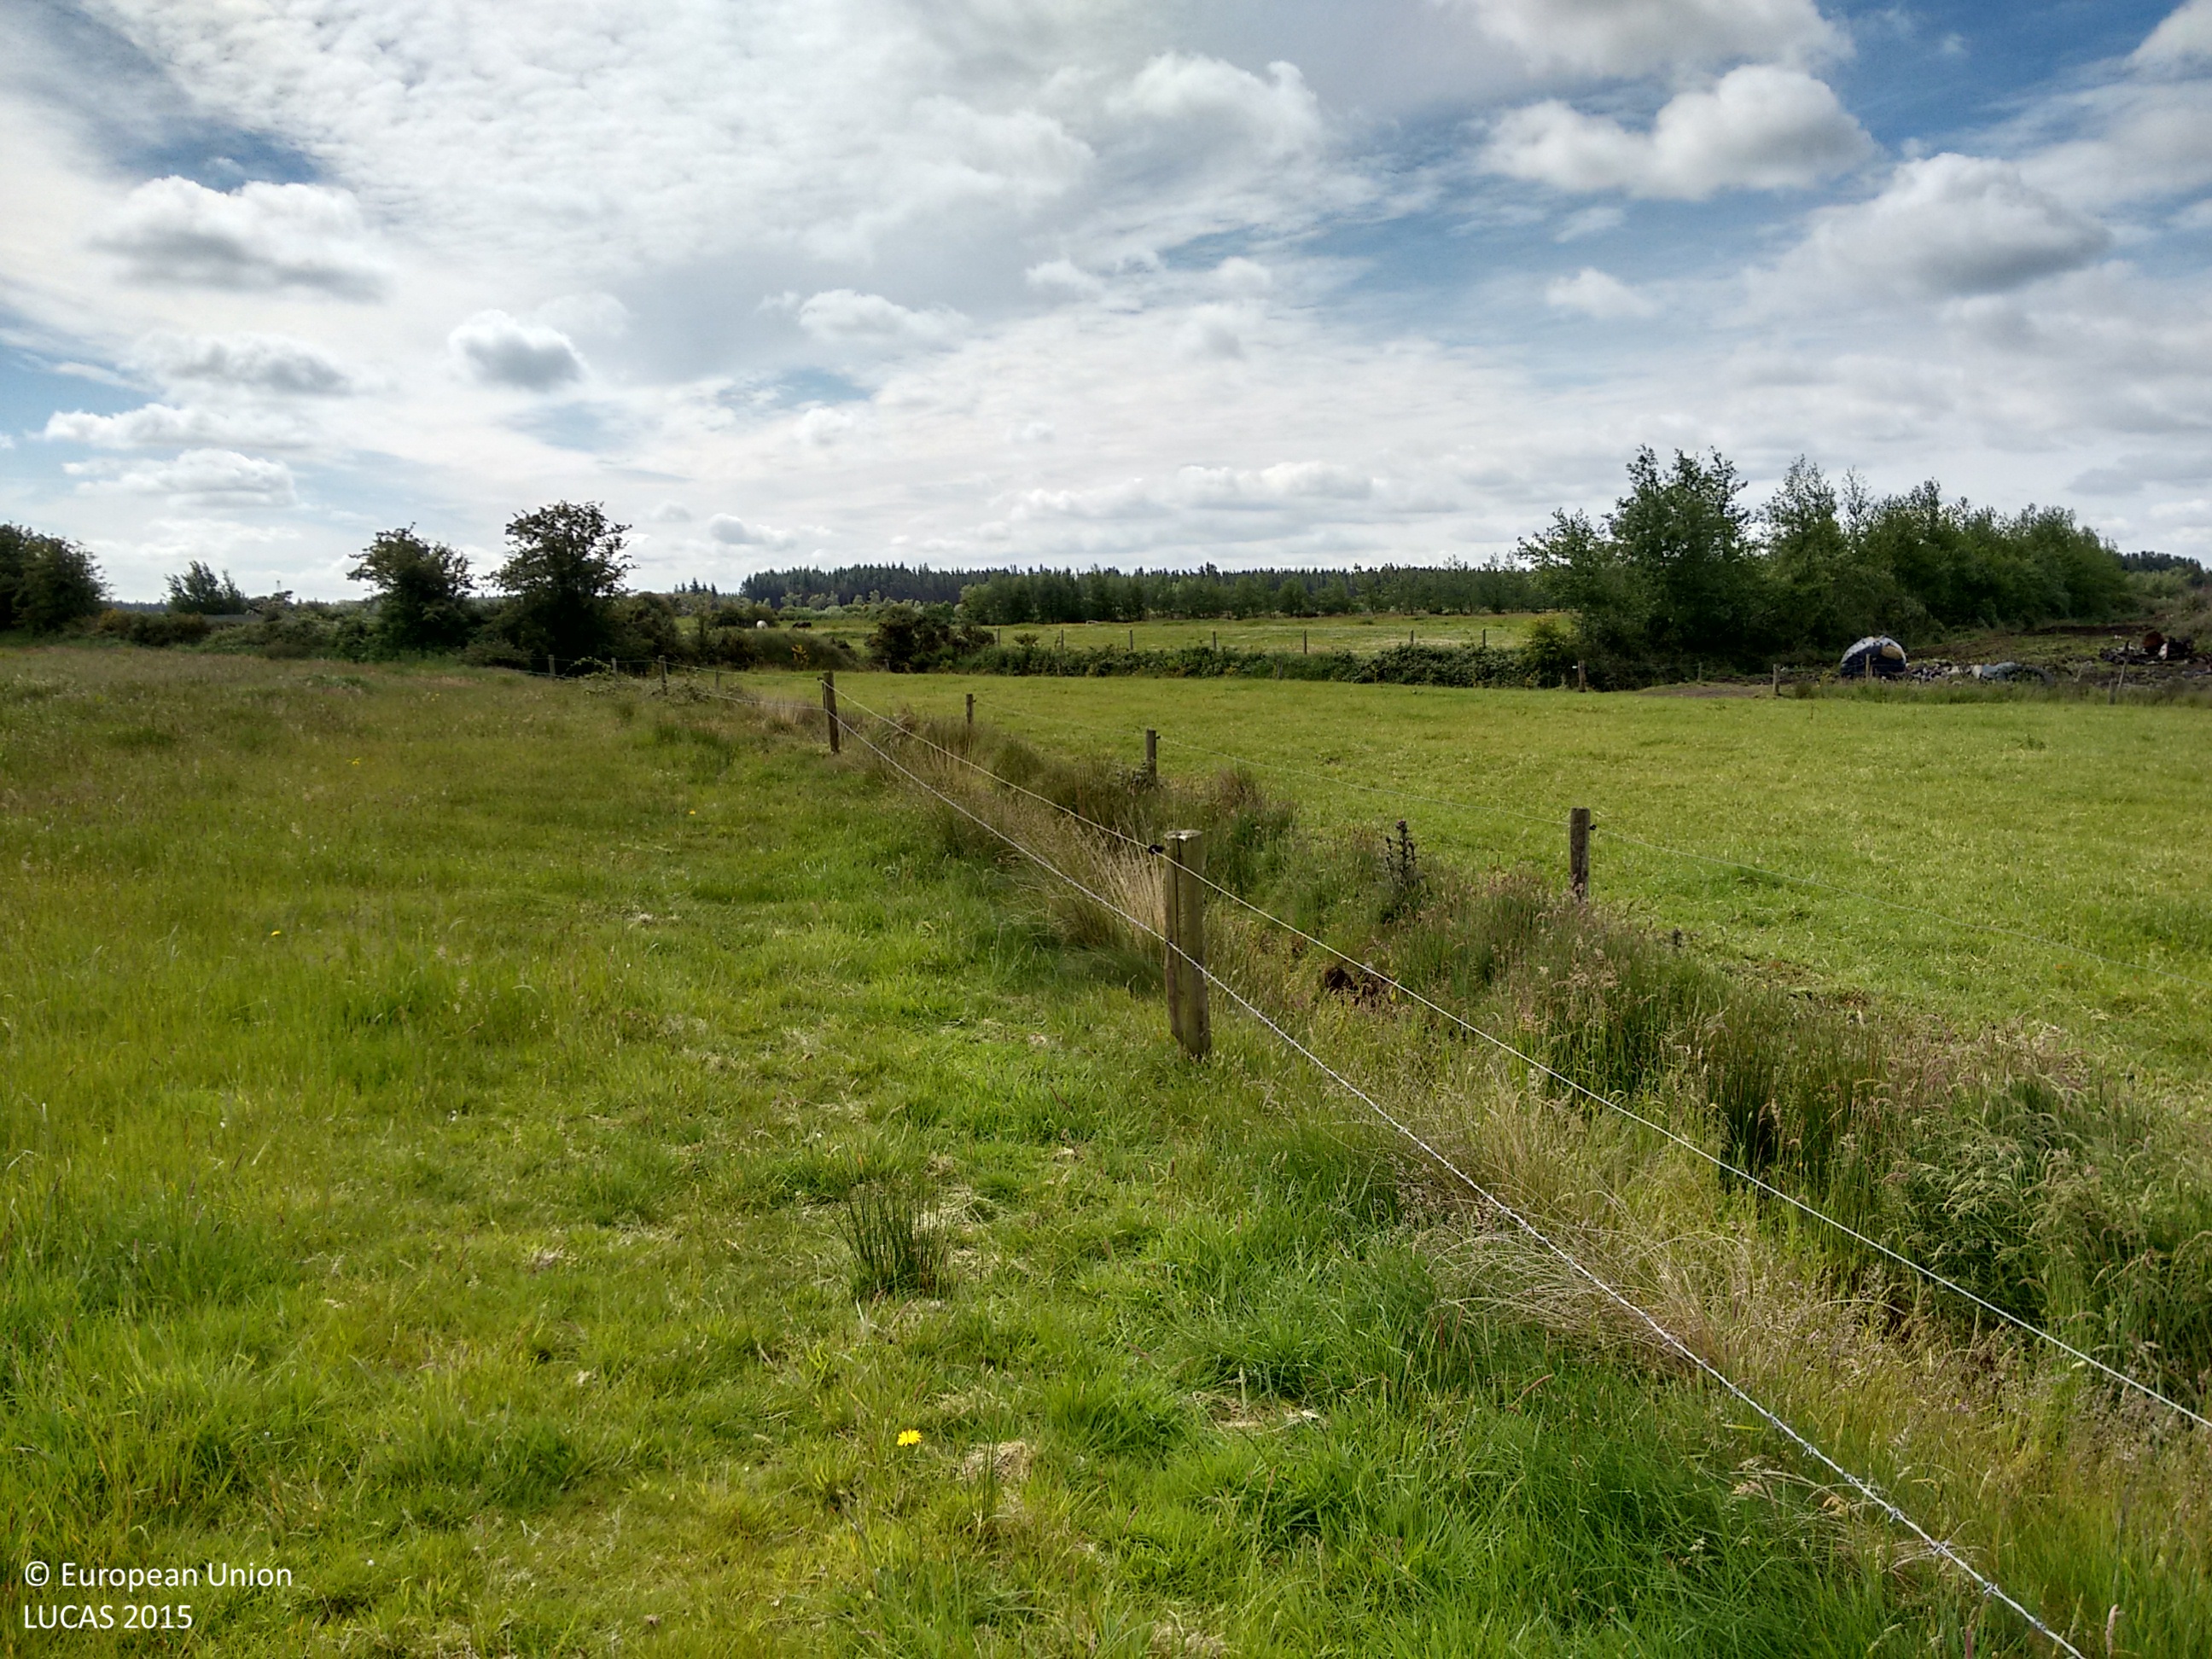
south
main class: Shrubland
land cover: Shrubland without tree cover
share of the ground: > 75 %
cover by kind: shrubs 80 %, herbaceous plants 20 %
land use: Agriculture (excluding fallow land and kitchen gardens)
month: June
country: IE
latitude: 53.5370
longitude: -8.6836
